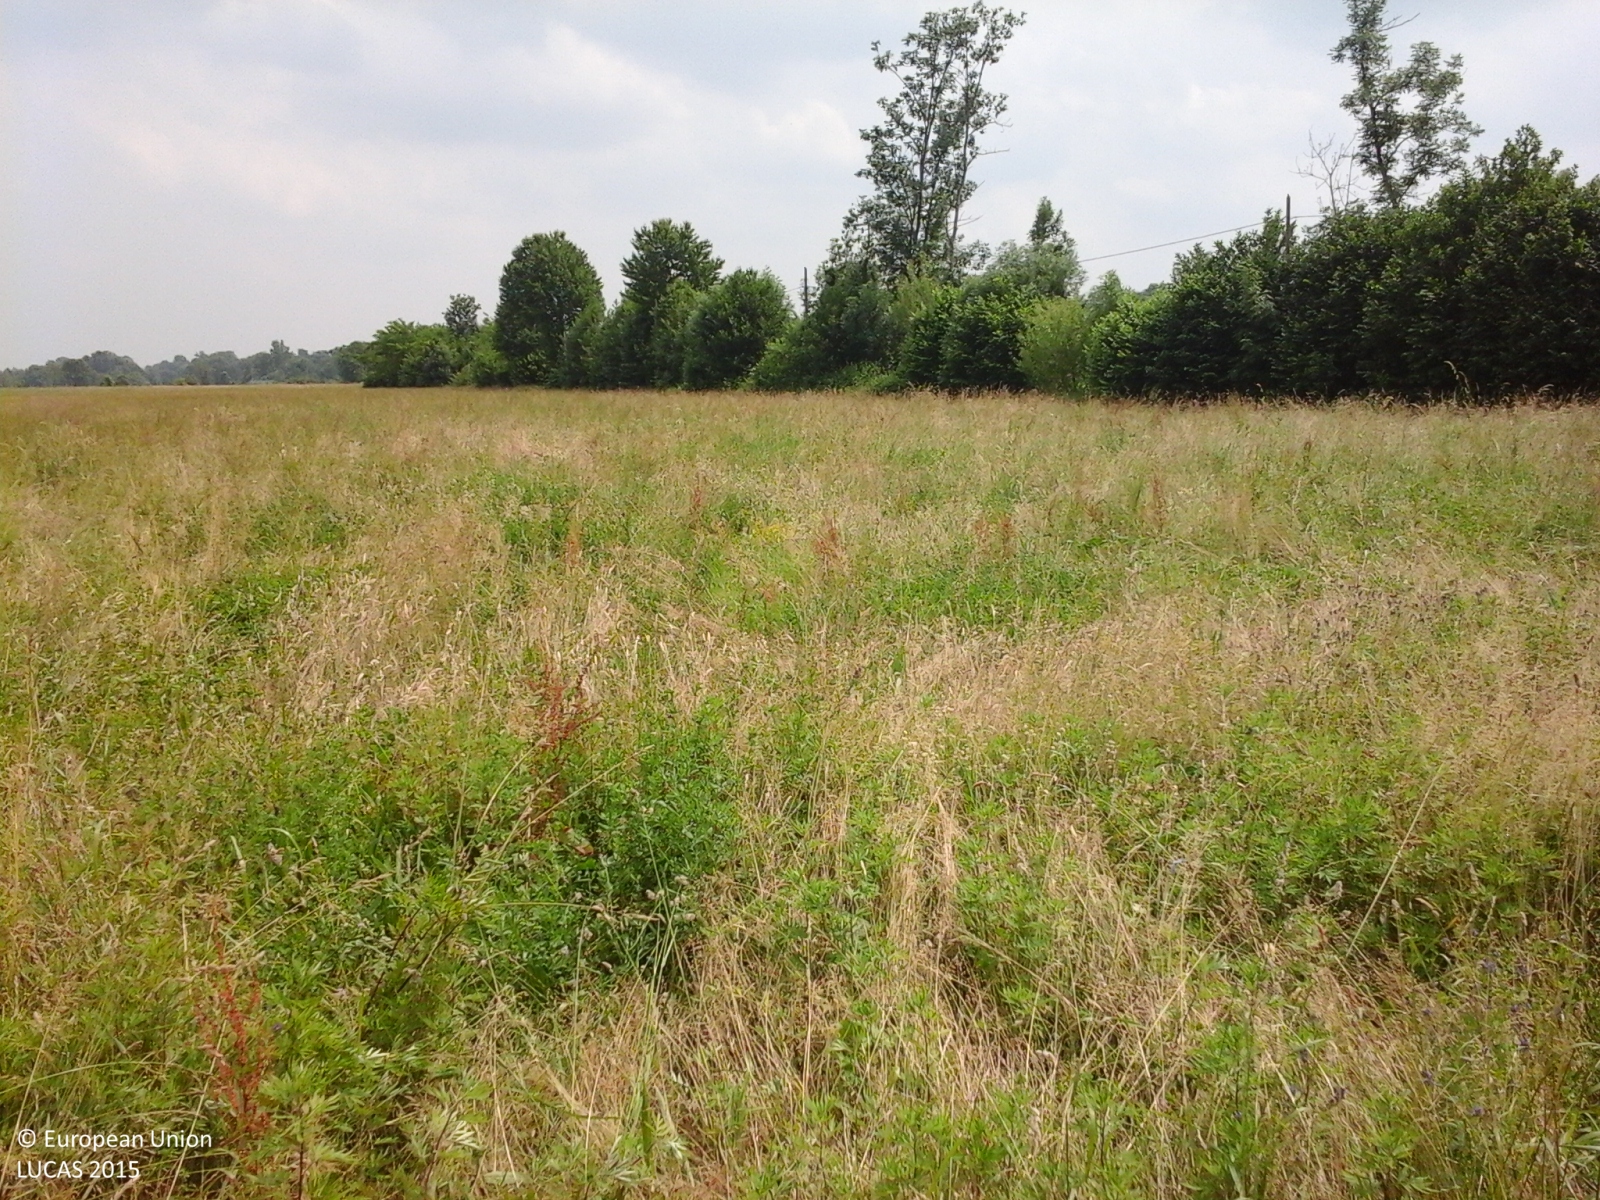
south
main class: Grassland
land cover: Grassland without tree/shrub cover
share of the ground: > 75 %
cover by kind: herbaceous plants 100 %
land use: Agriculture (excluding fallow land and kitchen gardens)
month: May
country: IT
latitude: 45.3885
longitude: 7.6664
